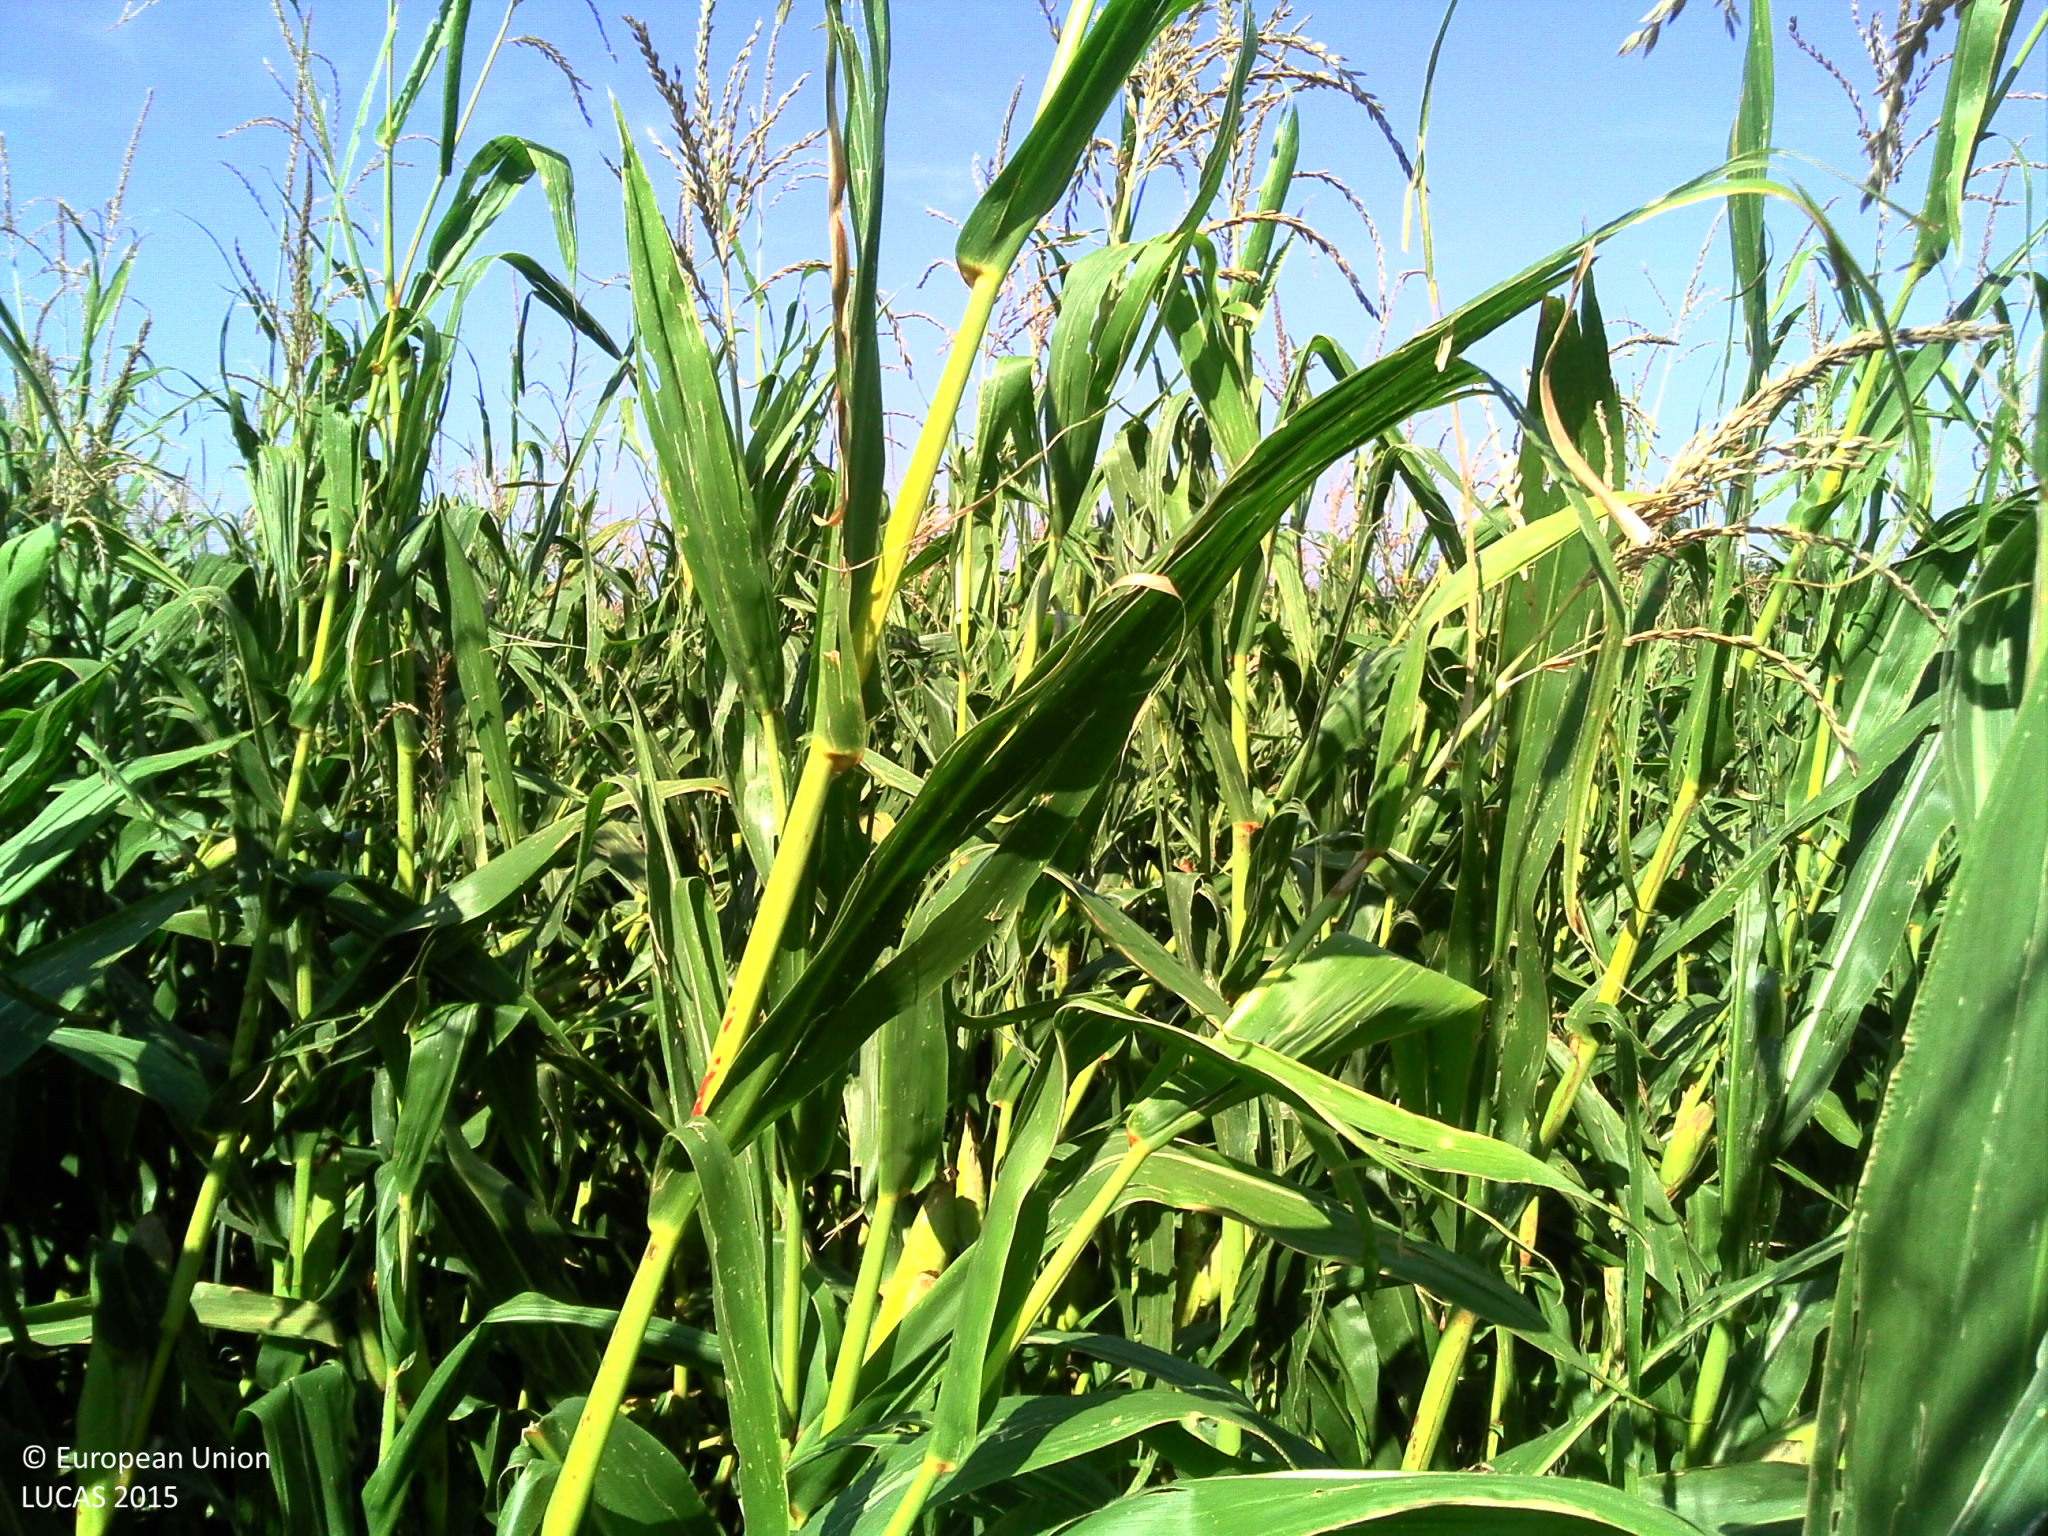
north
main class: Cropland
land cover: Maize
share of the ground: > 75 %
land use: Agriculture (excluding fallow land and kitchen gardens)
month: September
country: FR
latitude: 43.2638
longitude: -0.9139
